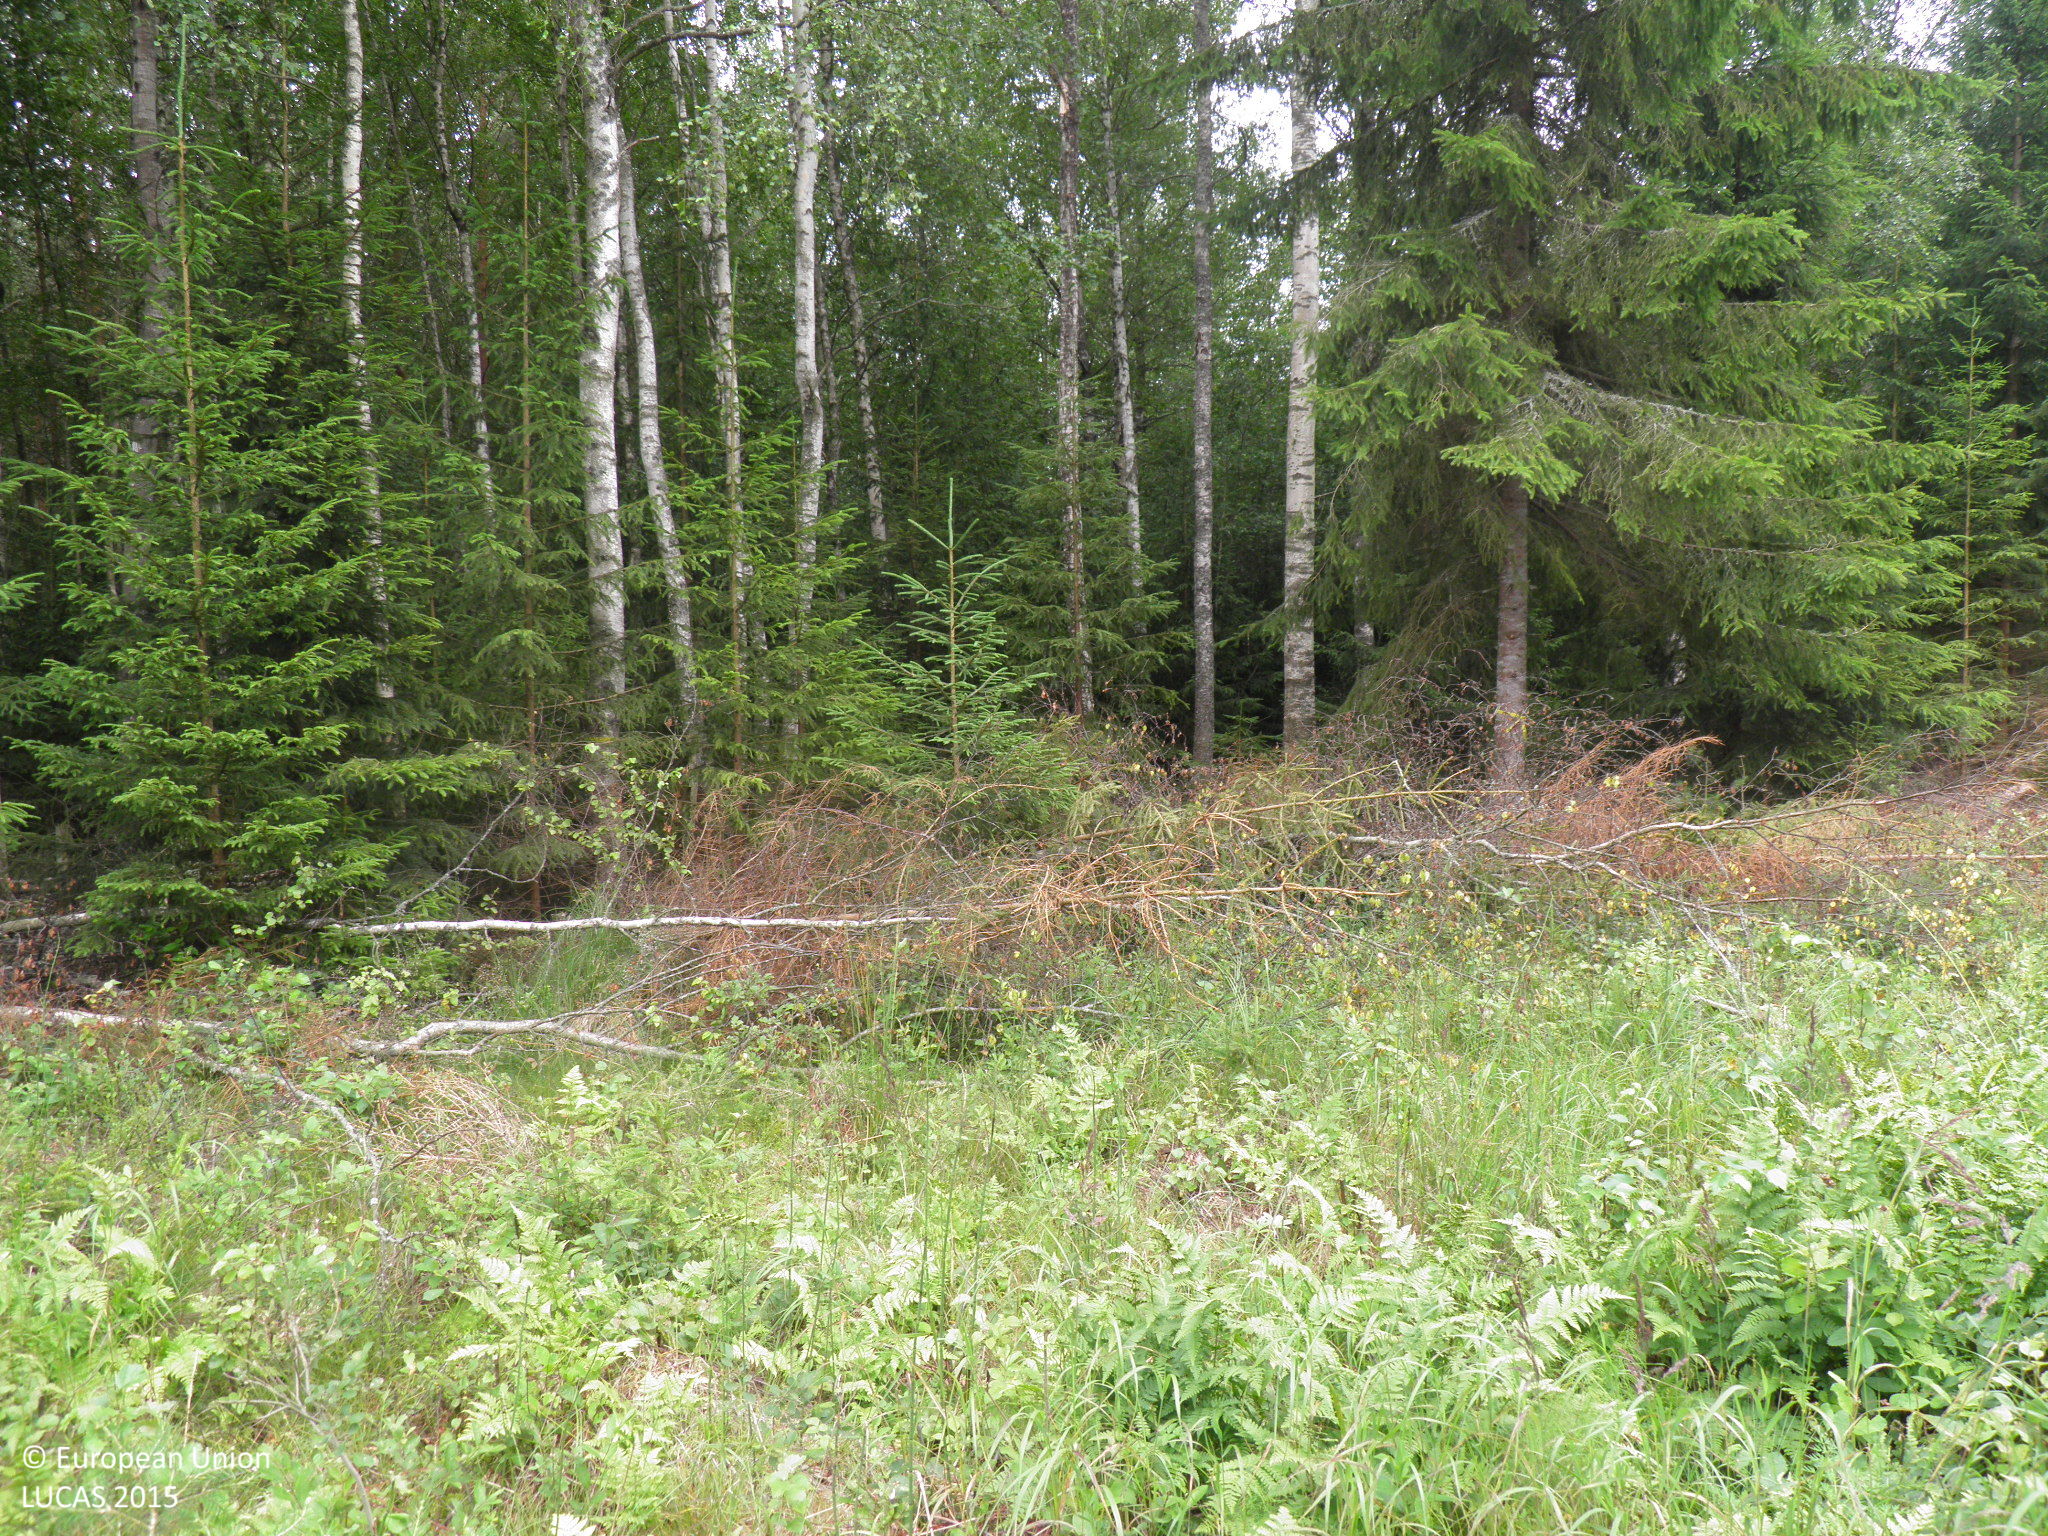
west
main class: Artificial land
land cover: Other artificial areas
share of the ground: > 75 %
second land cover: Shrubland with sparse tree cover
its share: > 75 %
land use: Electricity, gas and thermal power distribution
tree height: < 5 m
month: July
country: FI
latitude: 60.2157
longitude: 22.8004
